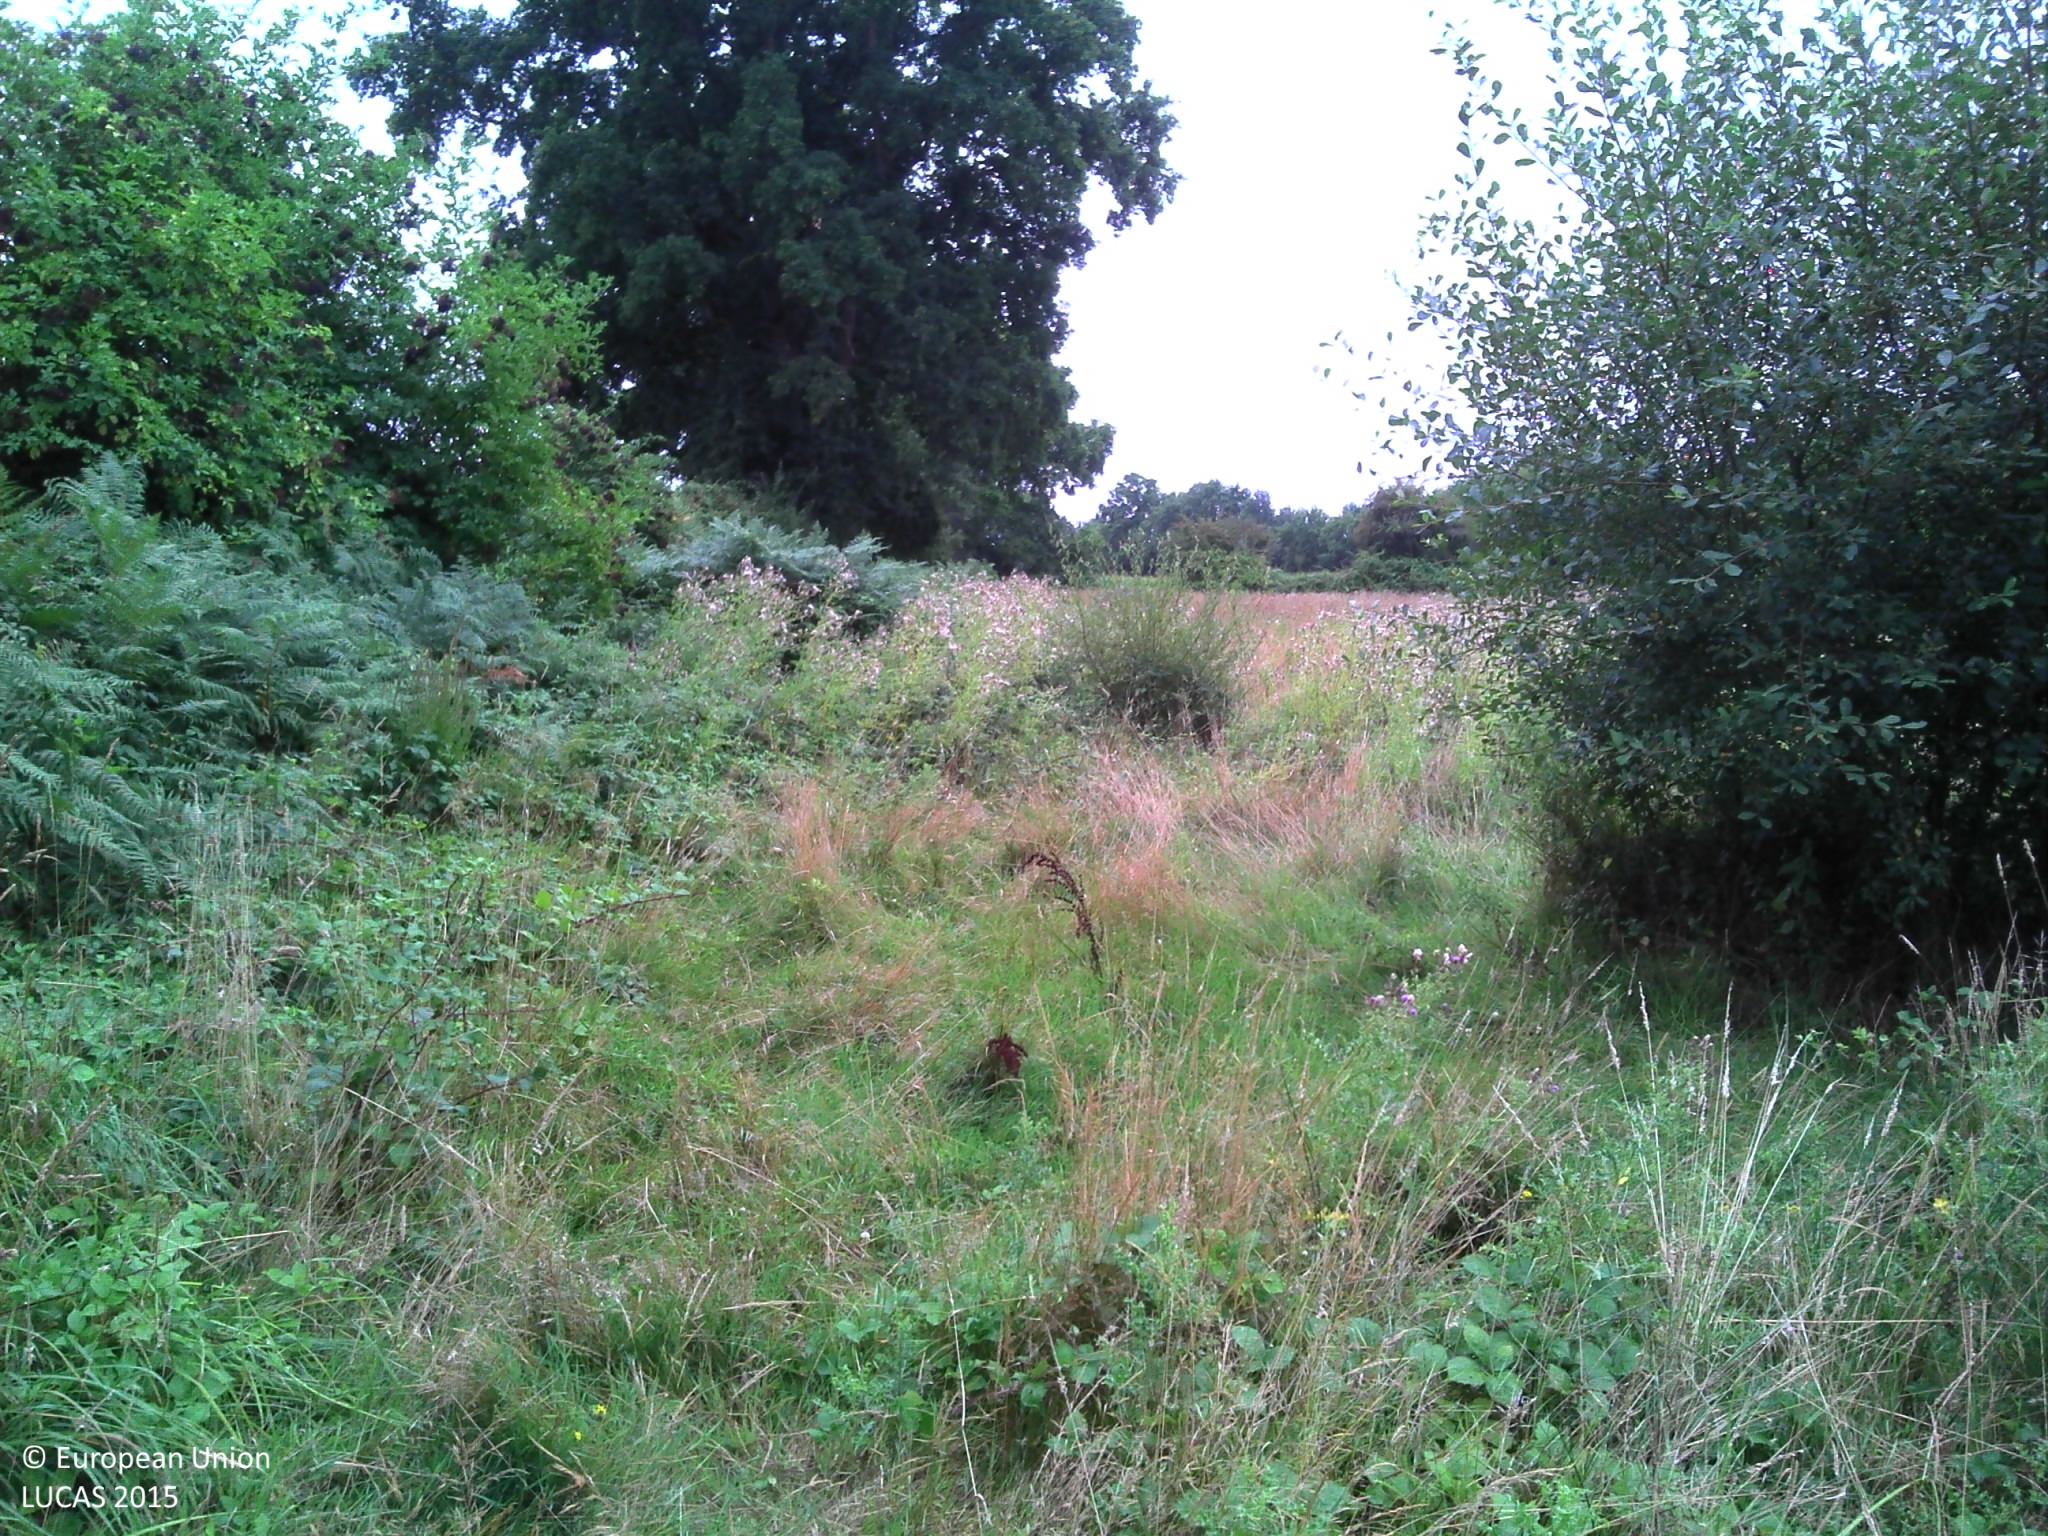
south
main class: Grassland
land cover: Spontaneously vegetated surfaces
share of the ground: > 75 %
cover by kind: herbaceous plants 95 %, shrubs 5 %
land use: Abandoned areas
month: August
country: FR
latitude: 47.5635
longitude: -1.5136
